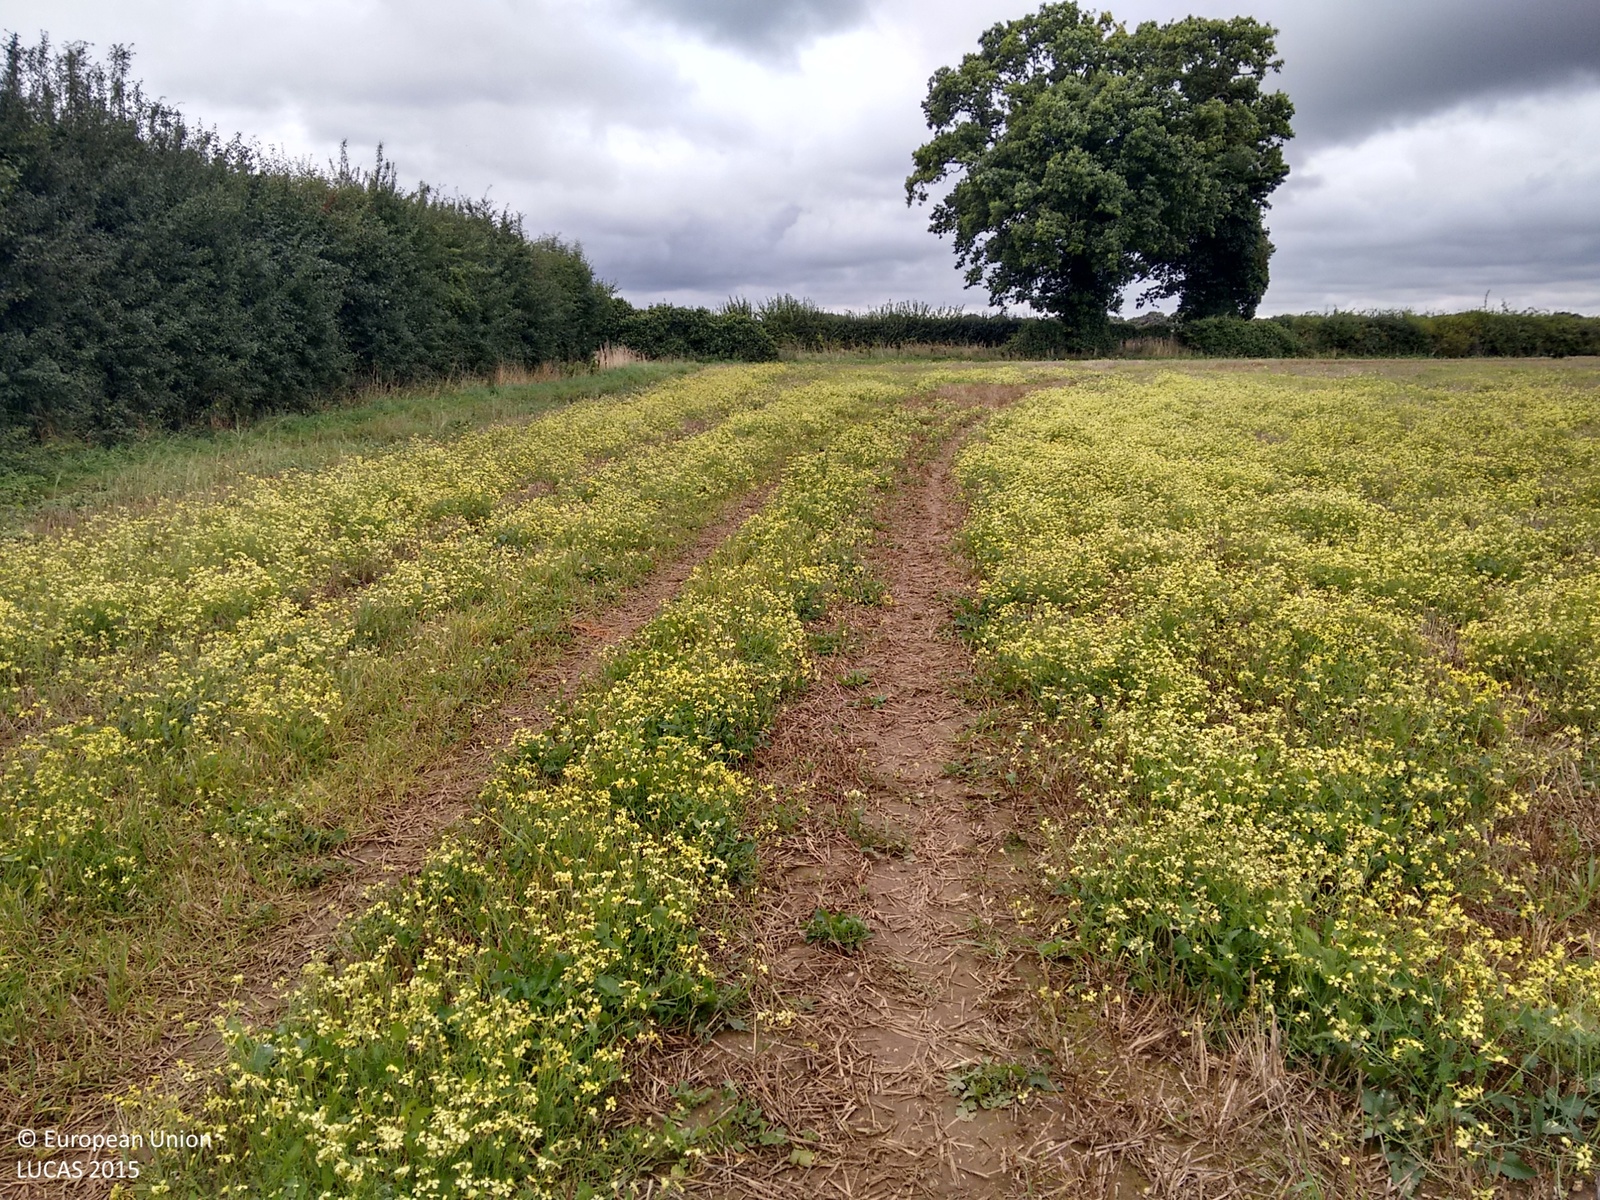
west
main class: Cropland
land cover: Common wheat
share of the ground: > 75 %
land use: Agriculture (excluding fallow land and kitchen gardens)
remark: Harvested field
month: September
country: GB
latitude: 52.6945
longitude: 1.3537
